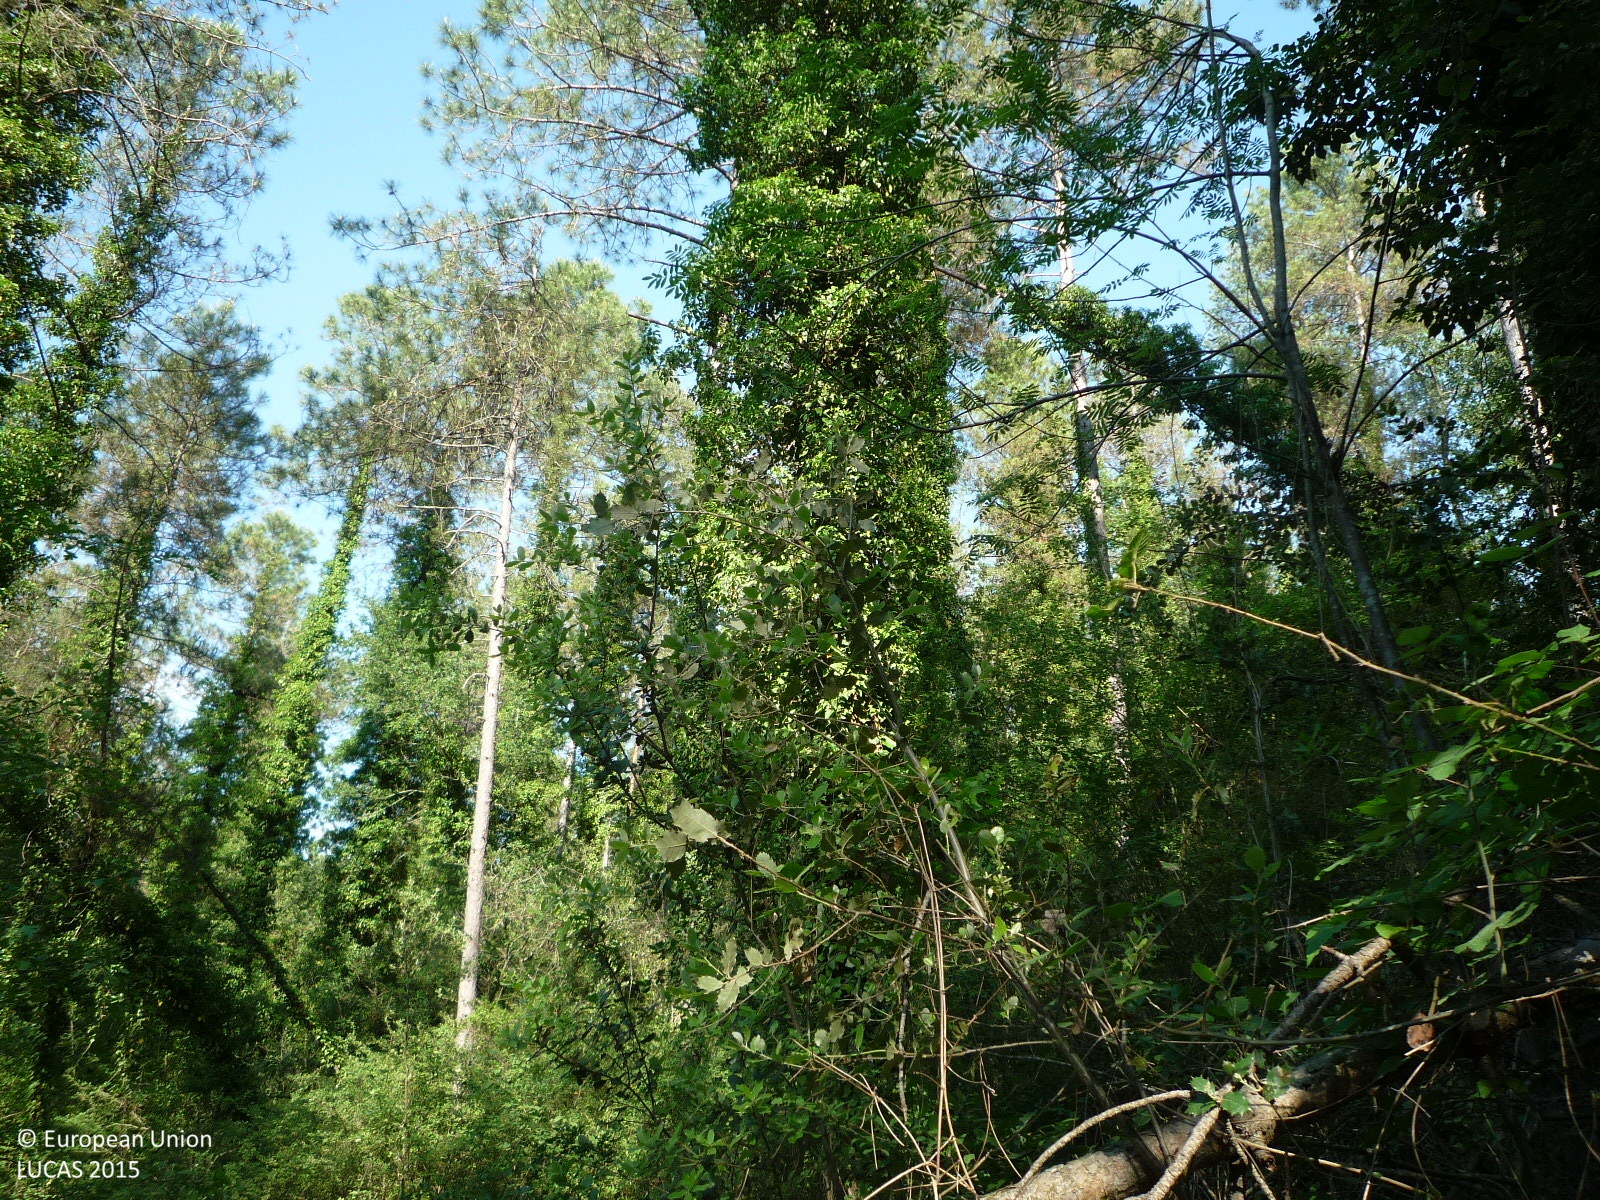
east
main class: Woodland
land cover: Pine dominated mixed woodland
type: coniferous forest of the mediterranean region
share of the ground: > 75 %
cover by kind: coniferous forest trees 70 %, broadleaved forest trees 30 %
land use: Semi-natural and natural areas not in use
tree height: > 5 m
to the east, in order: Pine dominated mixed woodland; Pine dominated coniferous woodland; Fences; Tracks; Pine dominated coniferous woodland
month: May
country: ES
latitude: 41.9016
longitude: 1.9984
